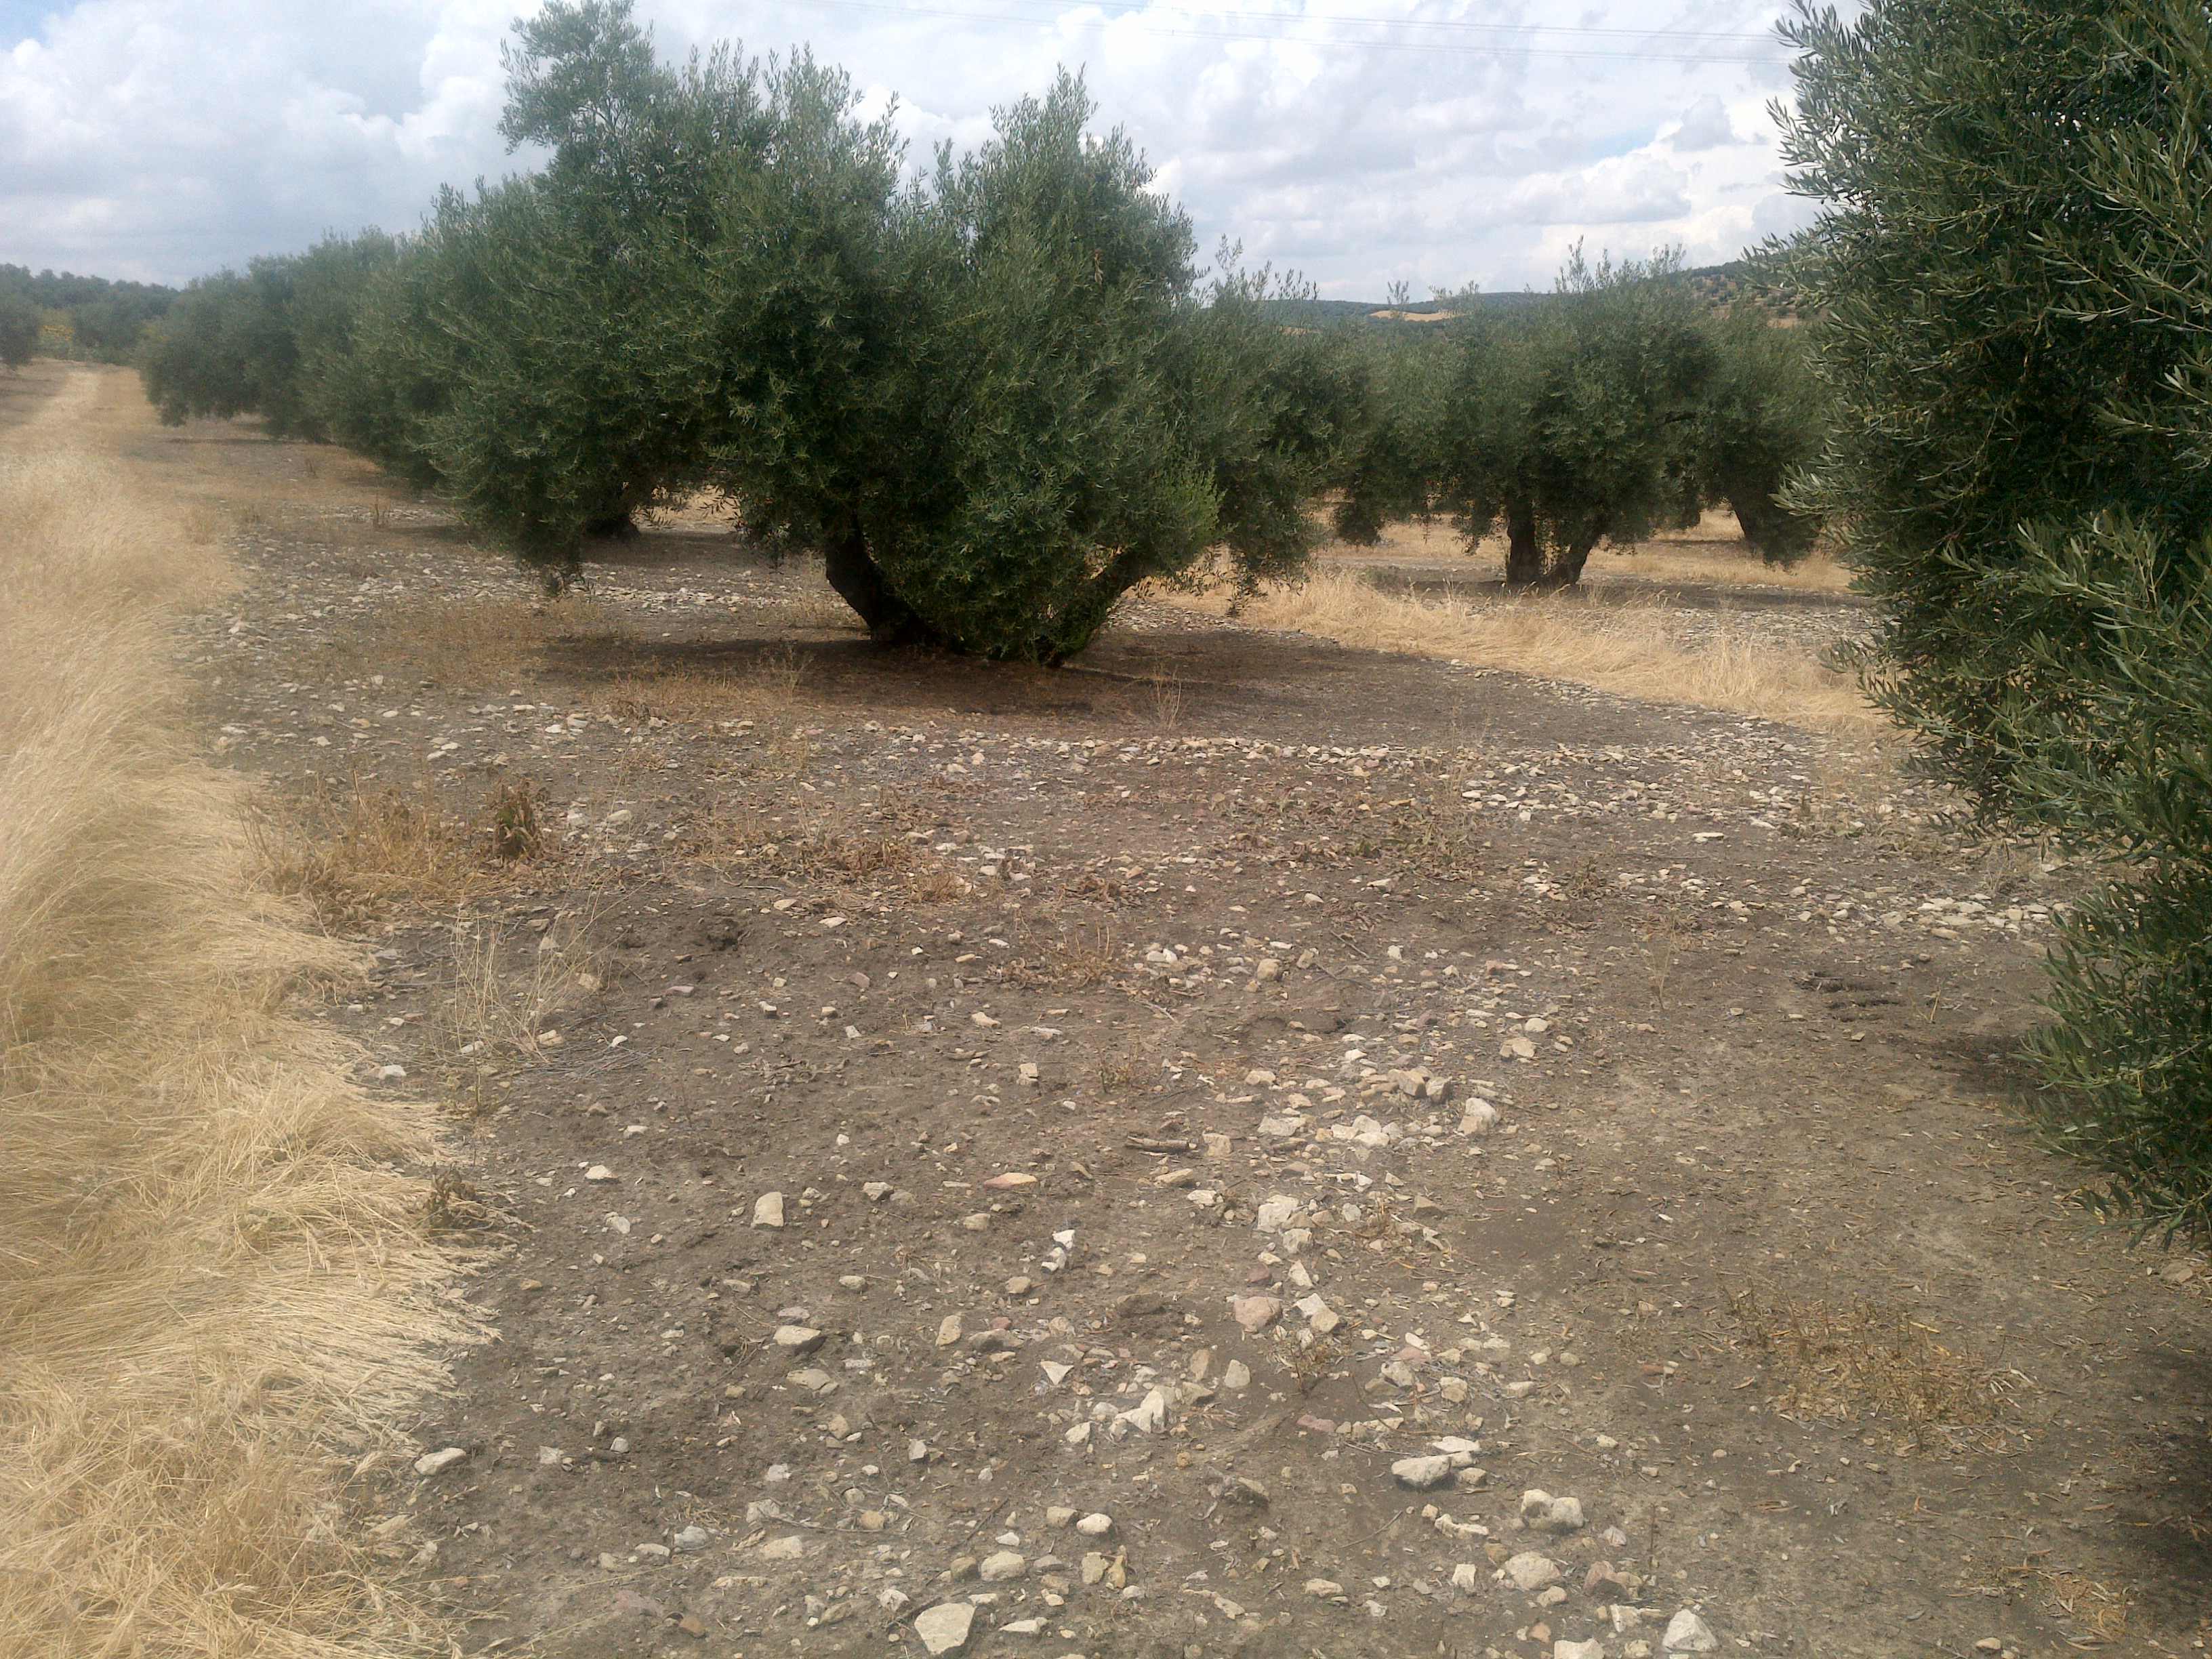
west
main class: Cropland
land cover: Olive groves
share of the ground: 50 - 75 %
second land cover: Spontaneously vegetated surfaces
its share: 10 - 25 %
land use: Agriculture (excluding fallow land and kitchen gardens)
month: June
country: ES
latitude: 37.8172
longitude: -4.3092
